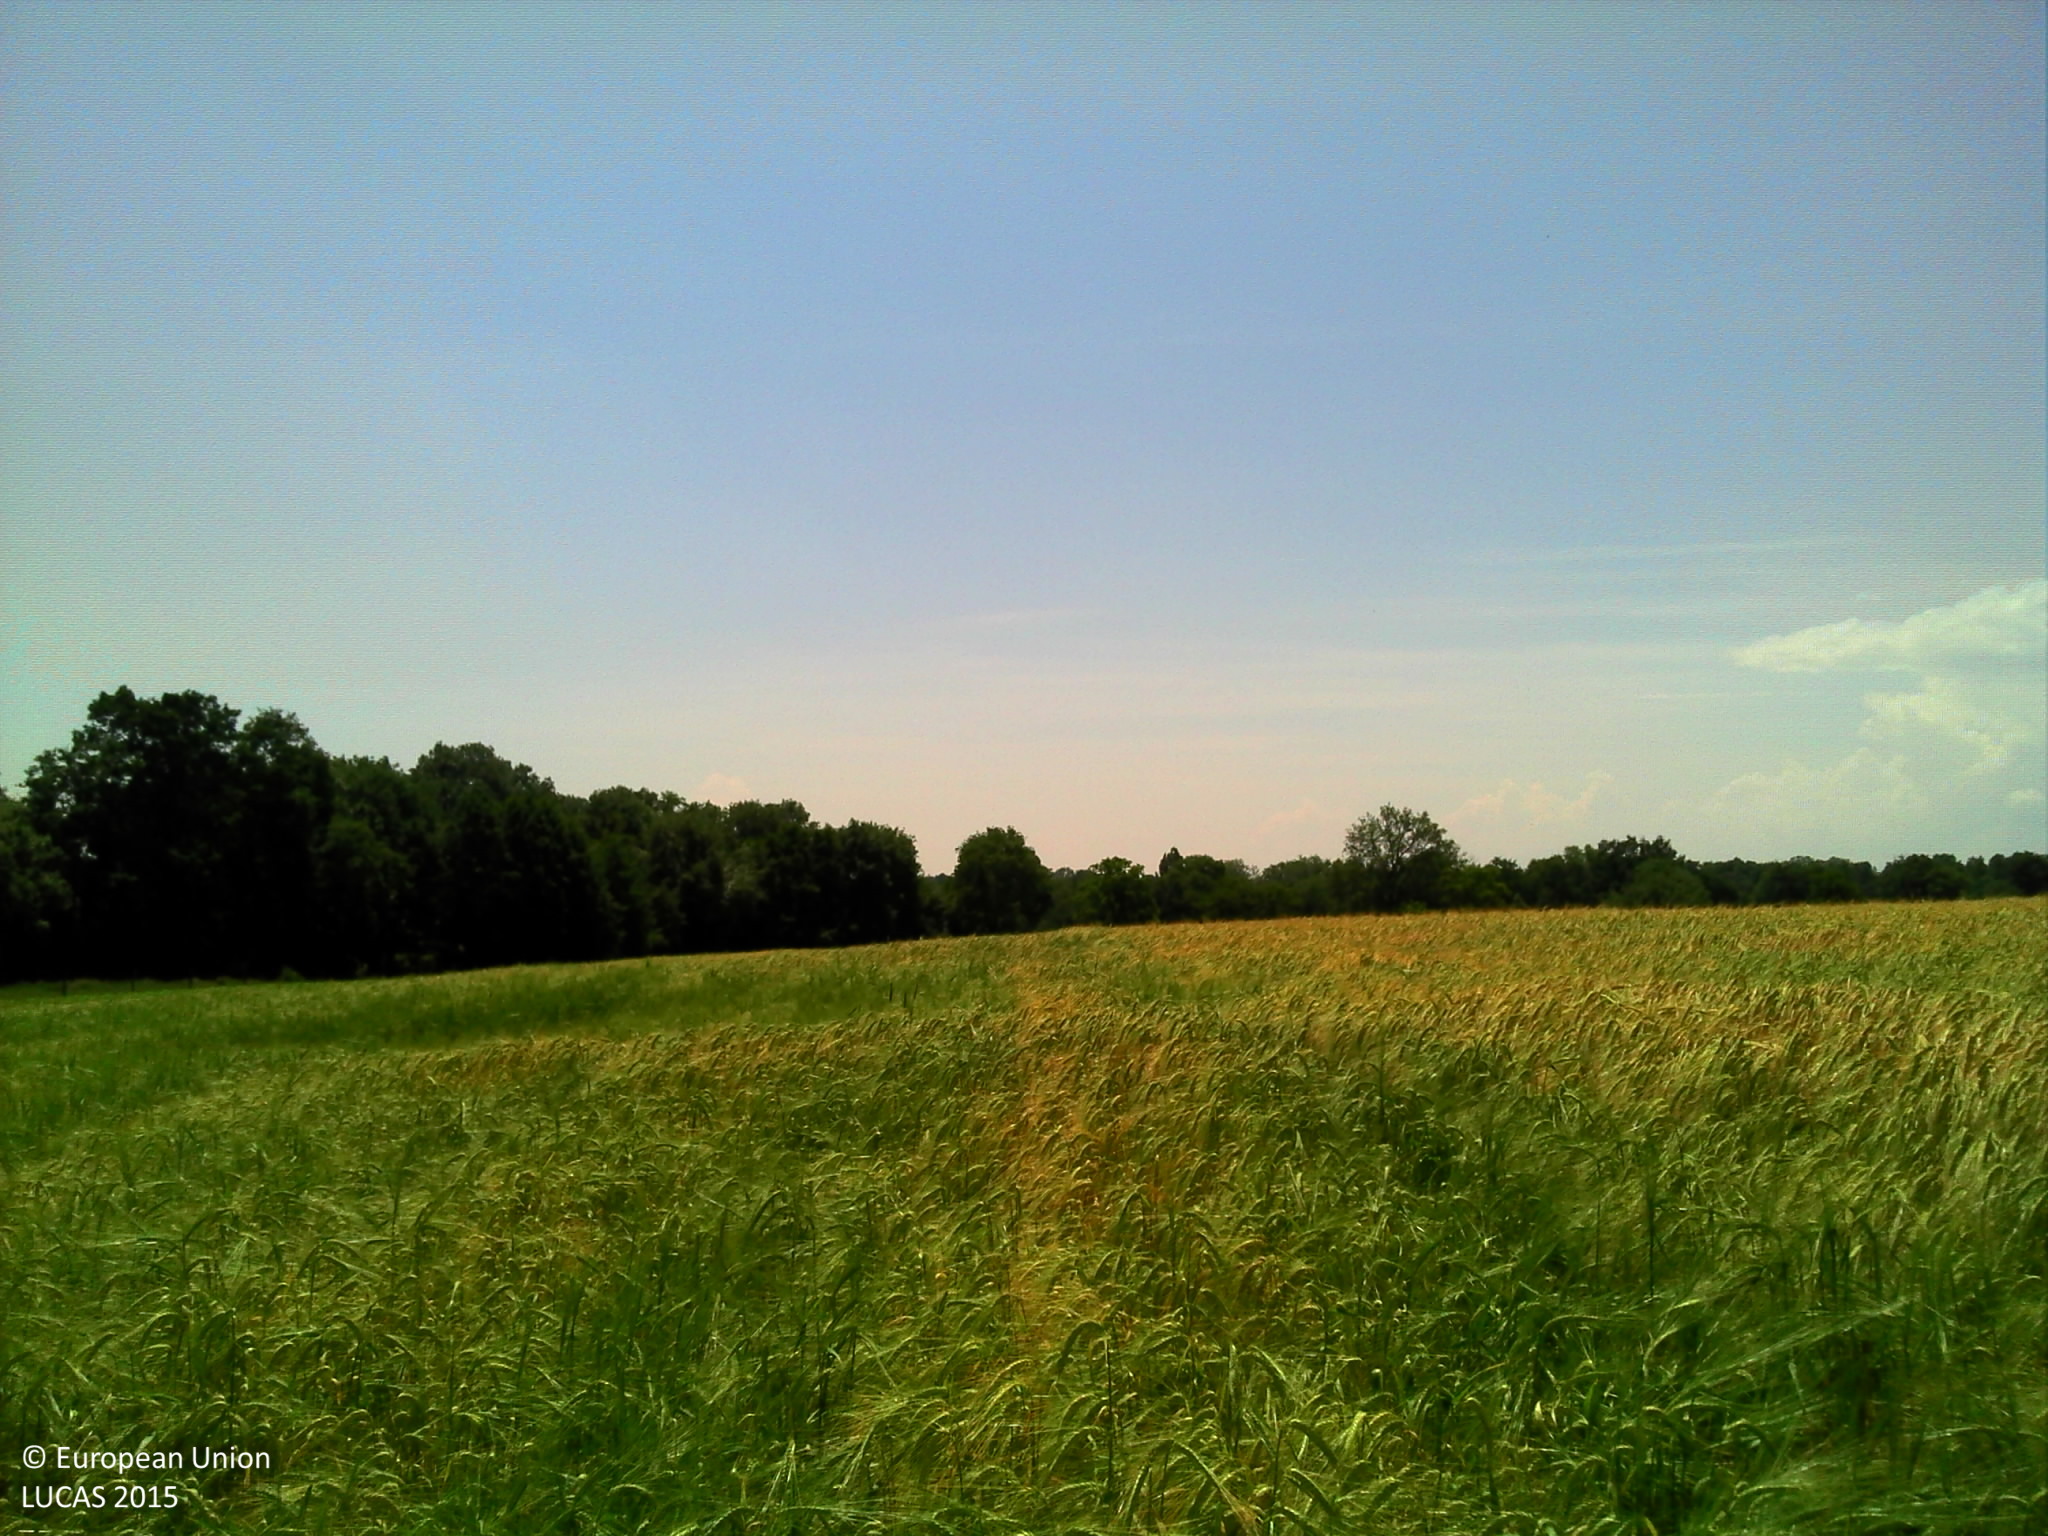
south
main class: Cropland
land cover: Barley
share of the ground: > 75 %
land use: Agriculture (excluding fallow land and kitchen gardens)
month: June
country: FR
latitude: 46.3597
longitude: 3.0444
